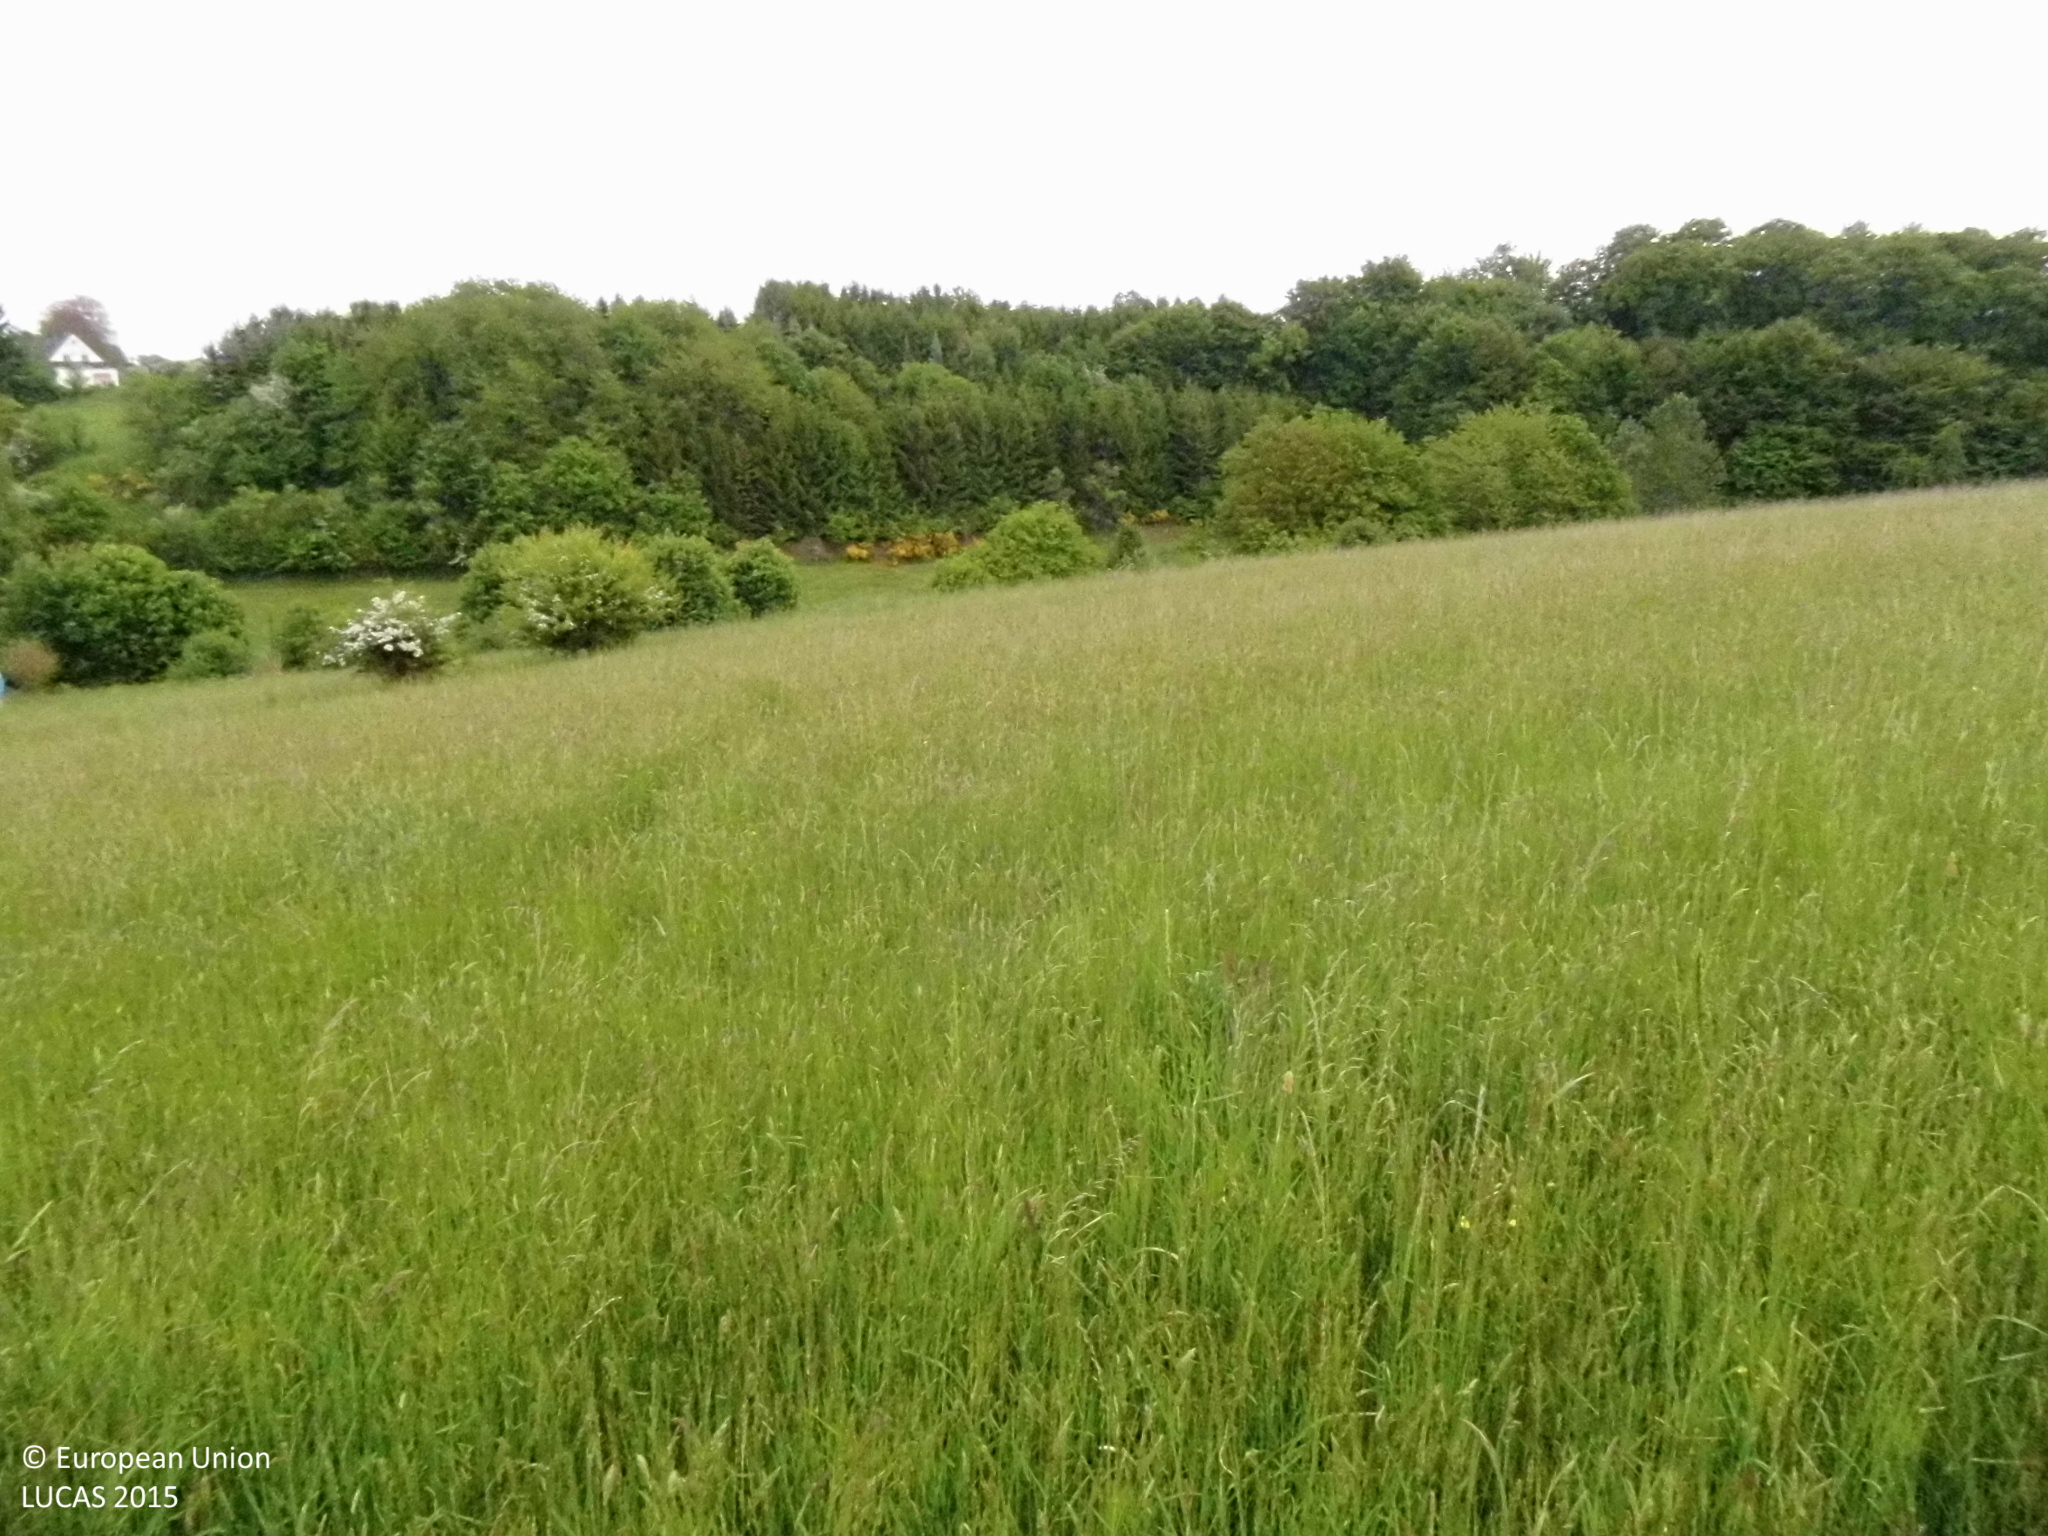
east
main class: Grassland
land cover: Grassland without tree/shrub cover
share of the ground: > 75 %
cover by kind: herbaceous plants 100 %
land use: Agriculture (excluding fallow land and kitchen gardens)
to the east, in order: Grassland without tree/shrub cover; Shrubland with sparse tree cover; Broadleaved woodland; Shruby margins; Paved roads, cycling and walking lanes; Grass margins; Electric lines; Fences; Grassland without tree/shrub cover; Rivers and streams; Grassland without tree/shrub cover; Fences; Shrubland with sparse tree cover; Other coniferous woodland; Broadleaved woodland; Other coniferous woodland; Groves; Grass margins; Paved roads, cycling and walking lanes; Shruby margins; Fences; Grassland without tree/shrub cover
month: May
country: DE
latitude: 50.5353
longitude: 7.5312
